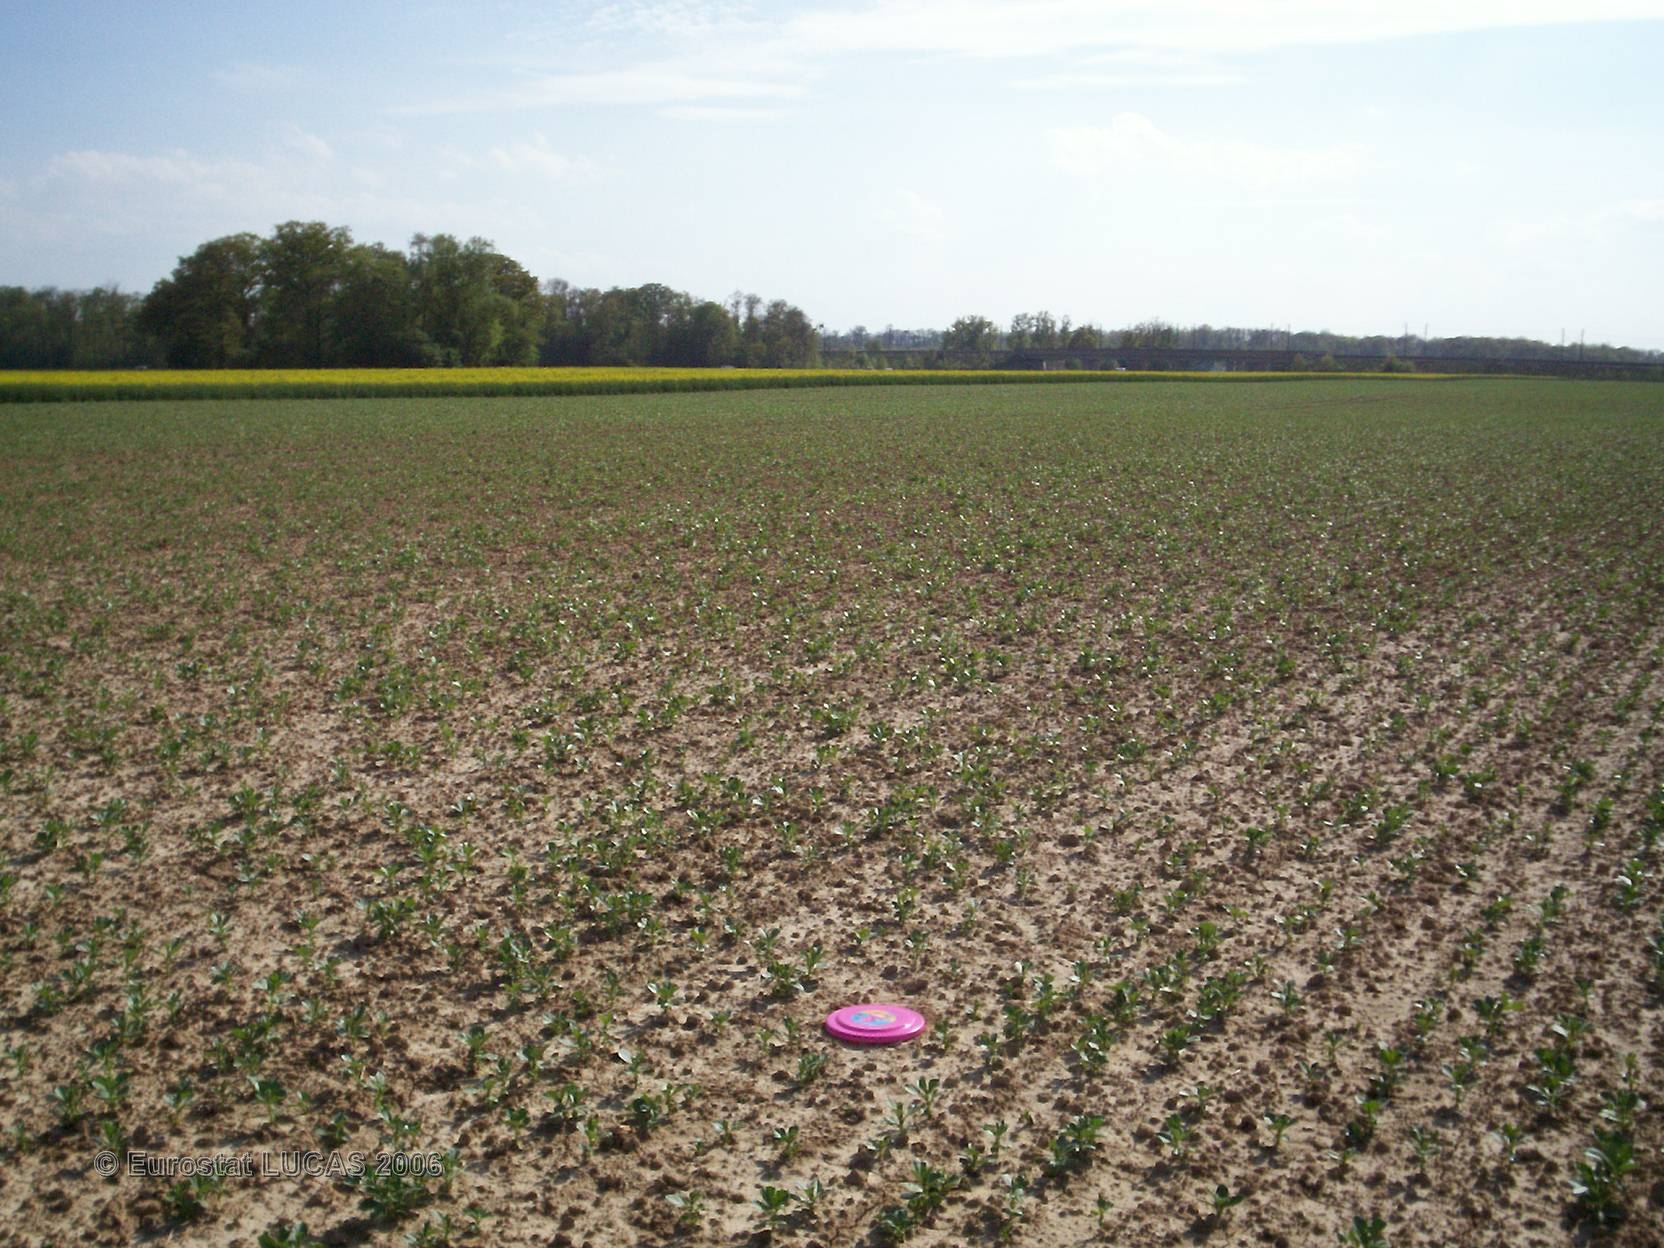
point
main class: Cropland
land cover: Sugar beet
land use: Agriculture (excluding fallow land and kitchen gardens)
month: May
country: FR
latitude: 48.8359
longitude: 2.7832
